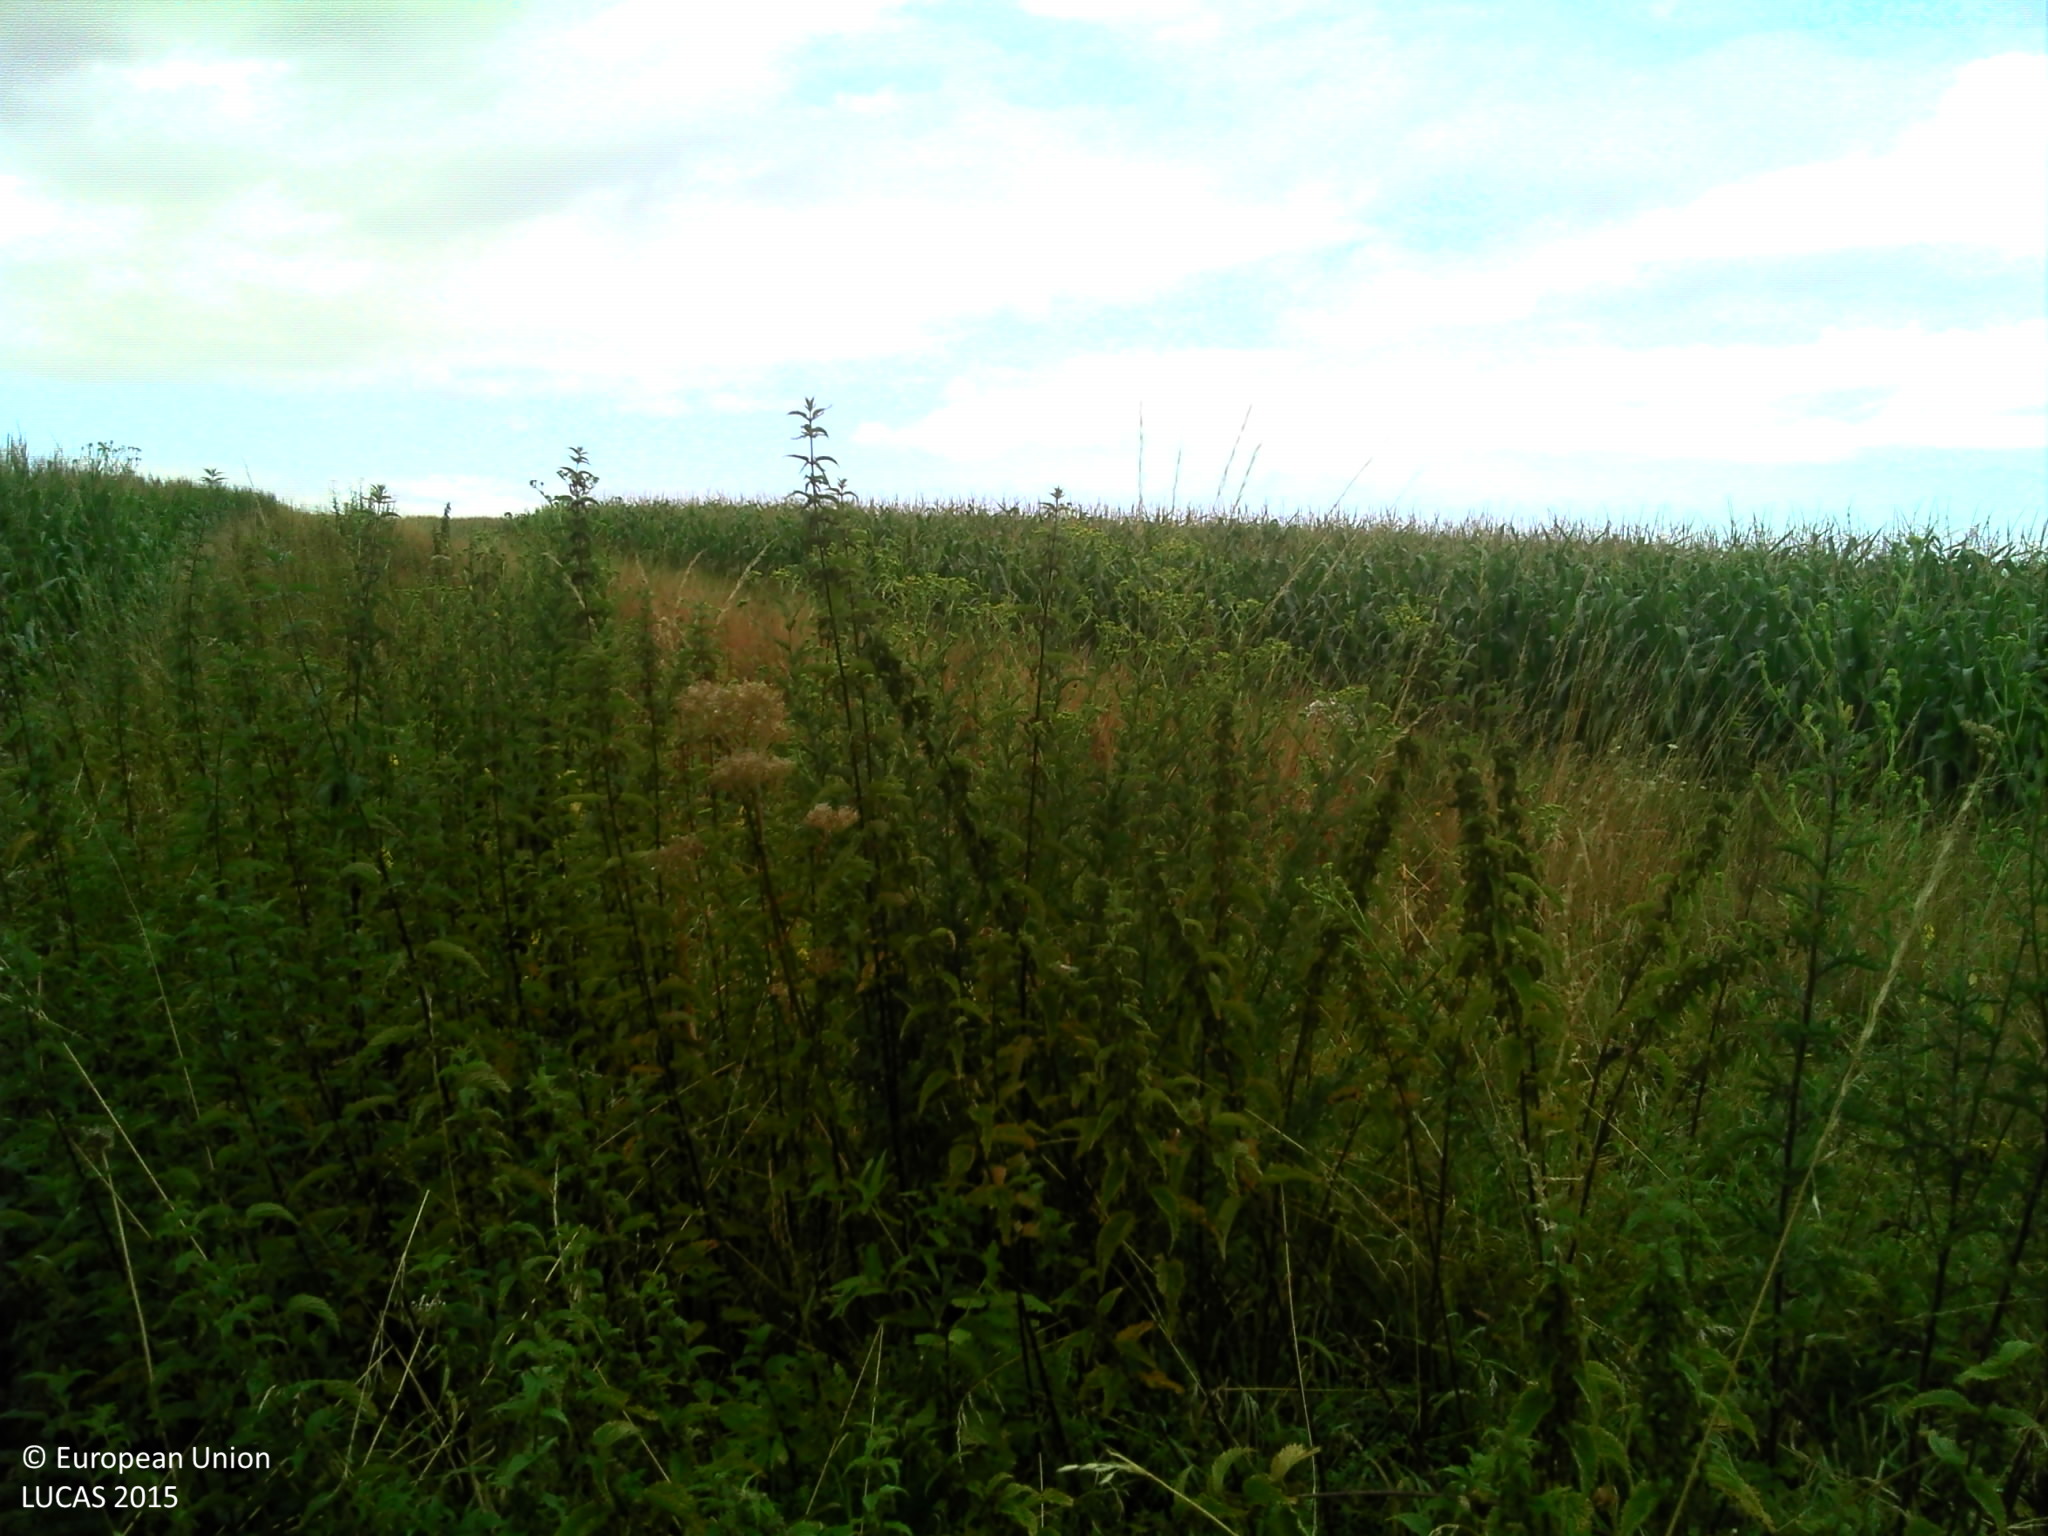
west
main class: Cropland
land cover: Maize
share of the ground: > 75 %
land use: Agriculture (excluding fallow land and kitchen gardens)
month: July
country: FR
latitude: 48.9020
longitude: 7.7224
